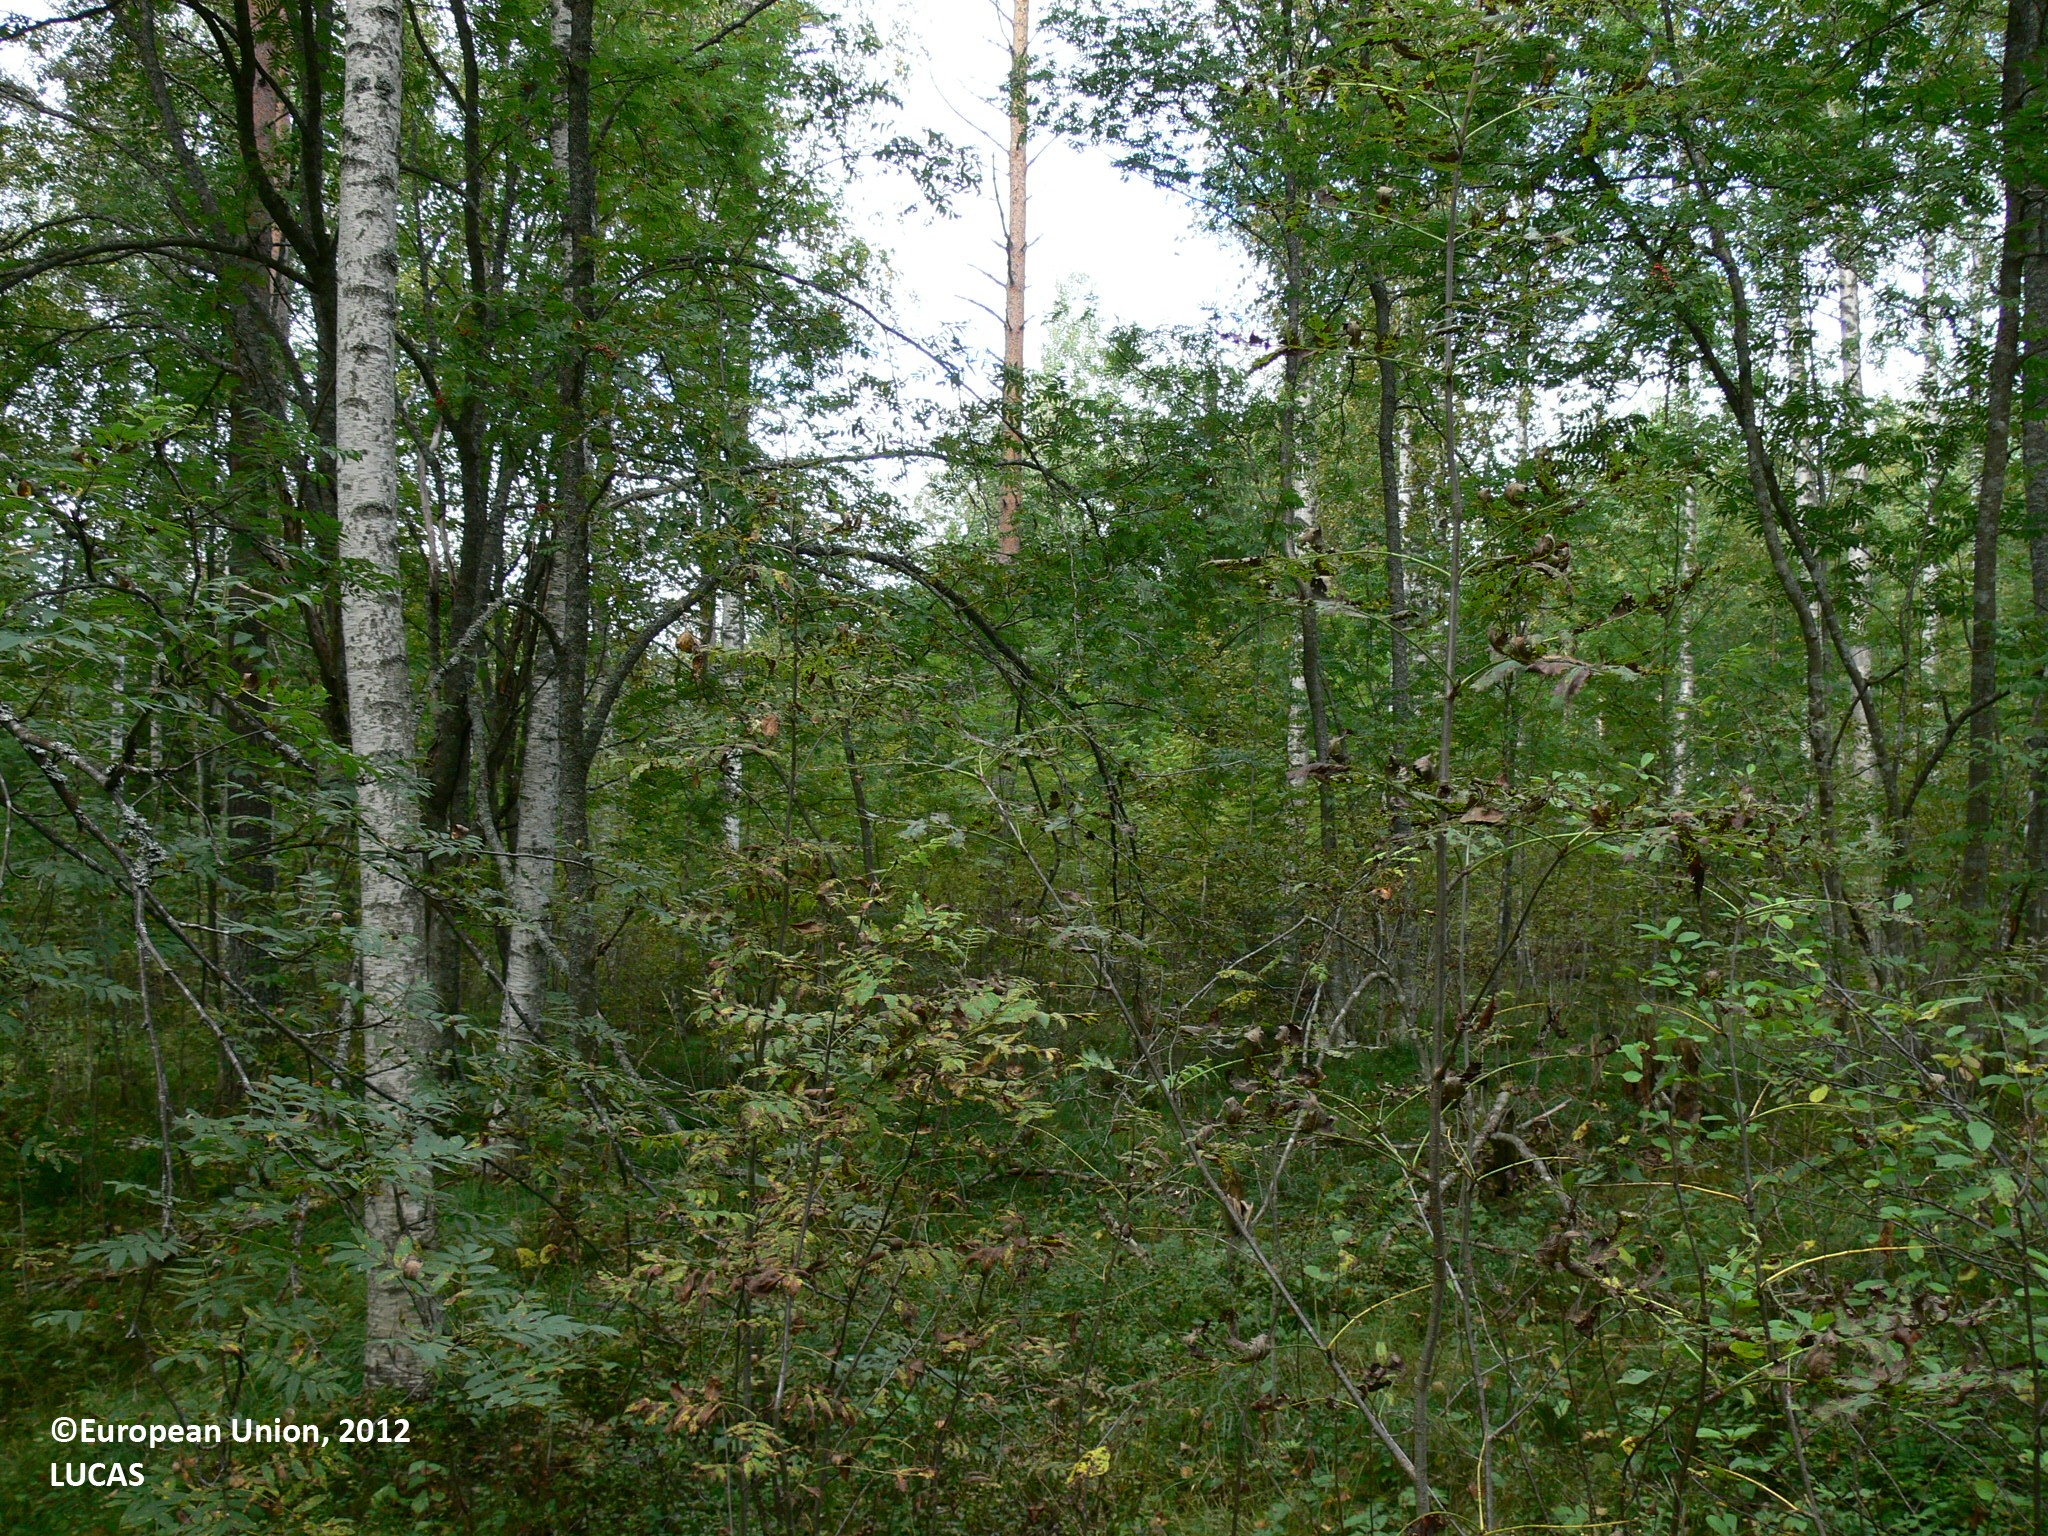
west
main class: Woodland
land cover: Other mixed woodland
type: boreal forest
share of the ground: > 75 %
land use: Forestry
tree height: > 5 m
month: August
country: FI
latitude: 62.0228
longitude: 30.2046
